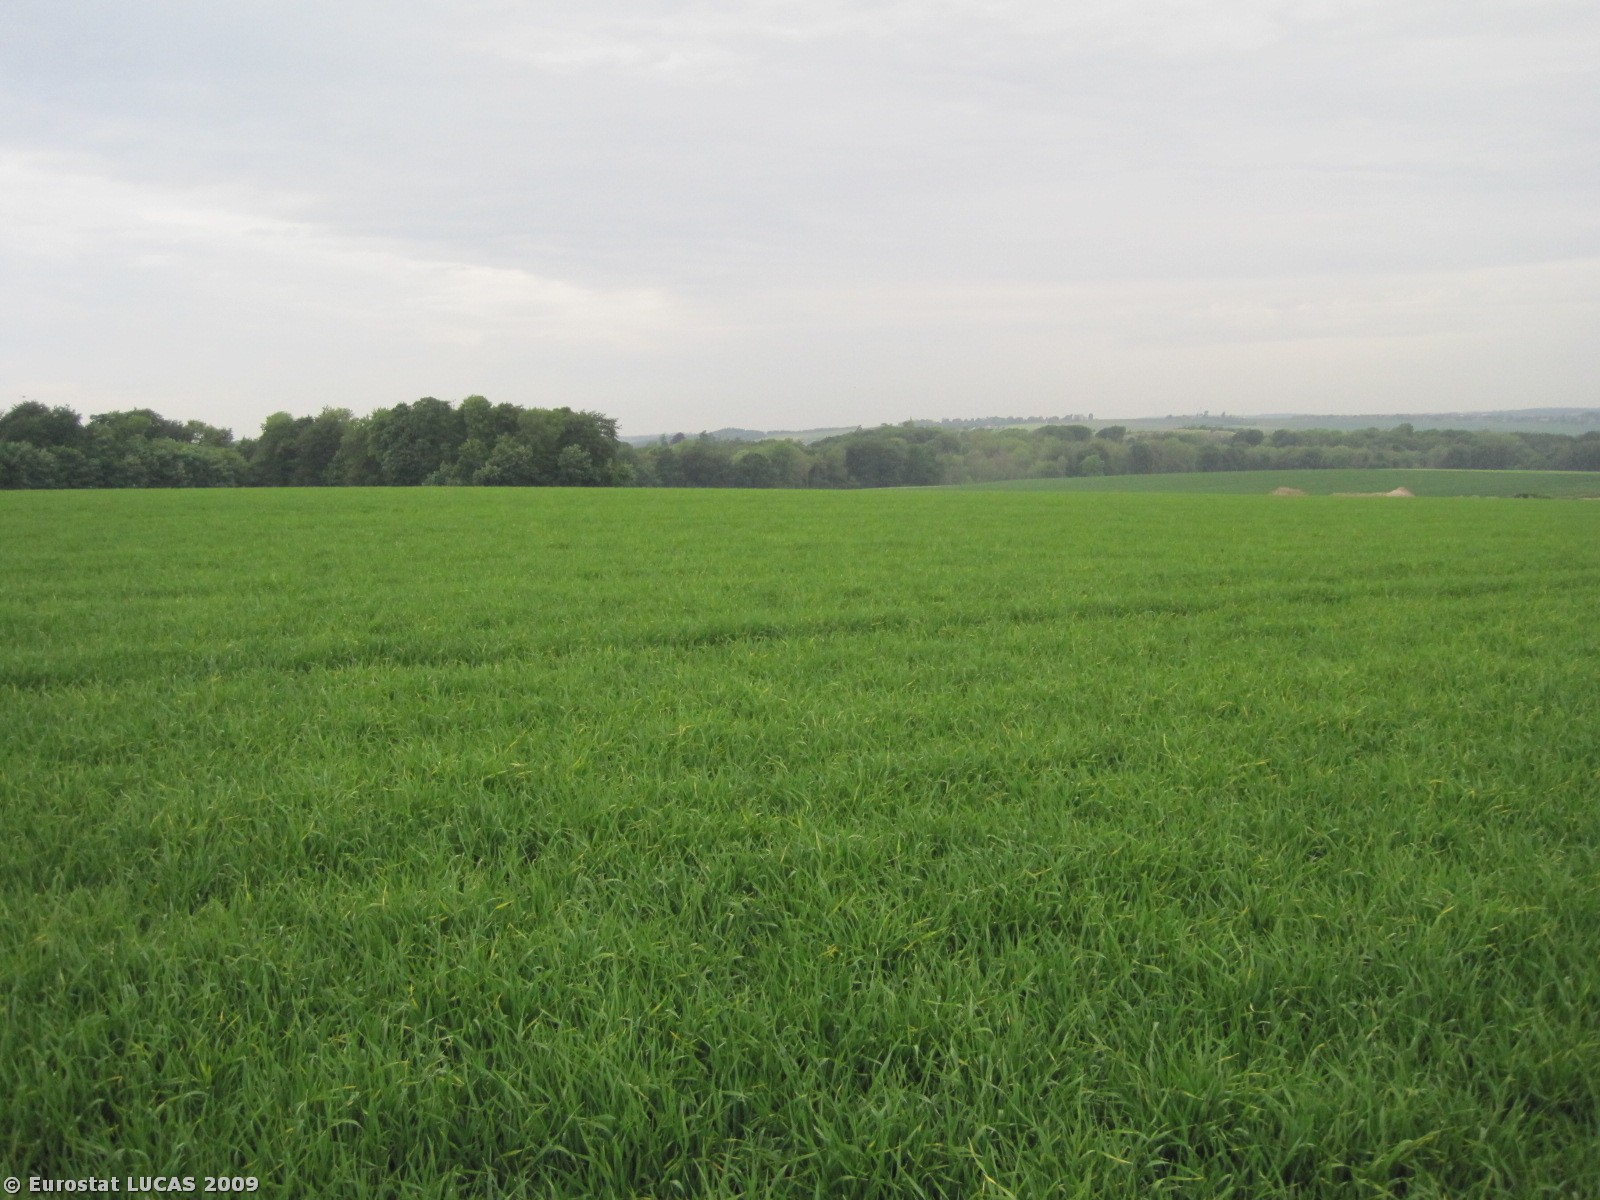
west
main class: Cropland
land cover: Barley
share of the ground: > 75 %
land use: Agriculture (excluding fallow land and kitchen gardens)
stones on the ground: < 10 %
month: May
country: DK
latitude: 56.4034
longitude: 9.9838
